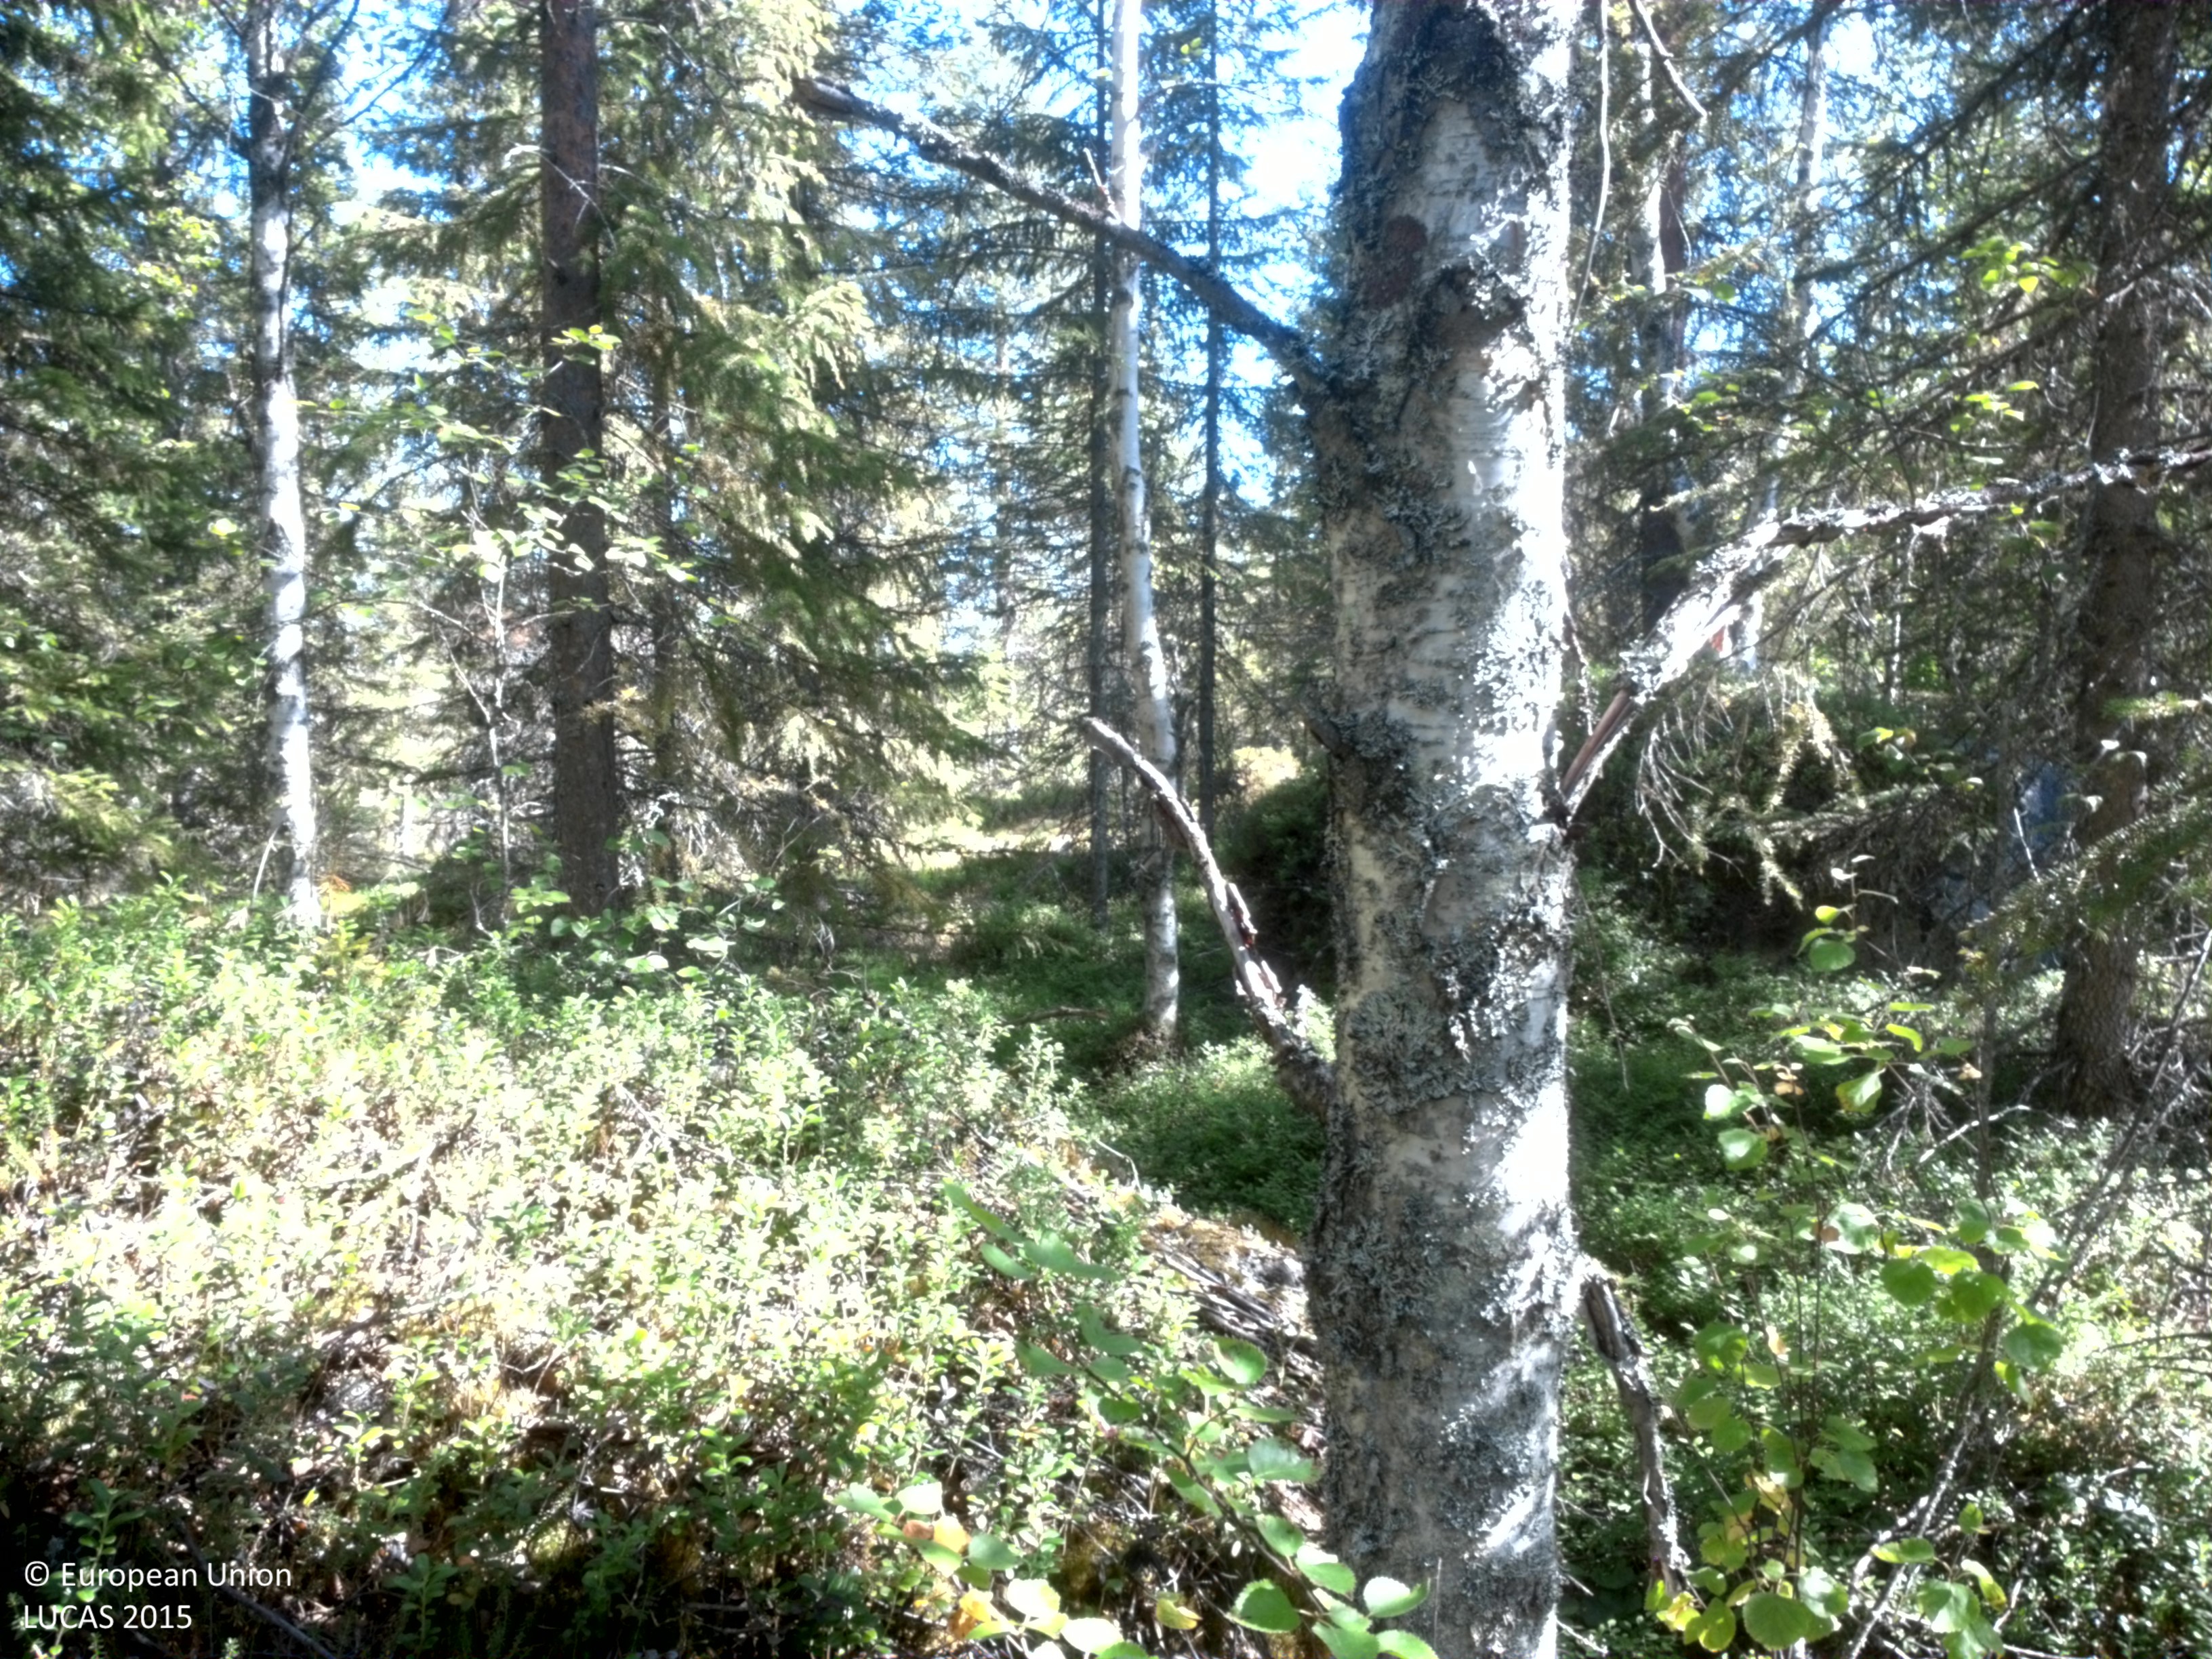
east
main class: Woodland
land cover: Pine dominated mixed woodland
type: boreal forest
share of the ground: 50 - 75 %
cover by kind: coniferous forest trees 45 %, shrubs 30 %, broadleaved forest trees 15 %, herbaceous plants 5 %, lichens and mosses 5 %
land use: Forestry
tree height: > 5 m
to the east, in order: Pine dominated mixed woodland; Spruce dominated coniferous woodland; Pine dominated coniferous woodland
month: August
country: SE
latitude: 64.4847
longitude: 18.3951
